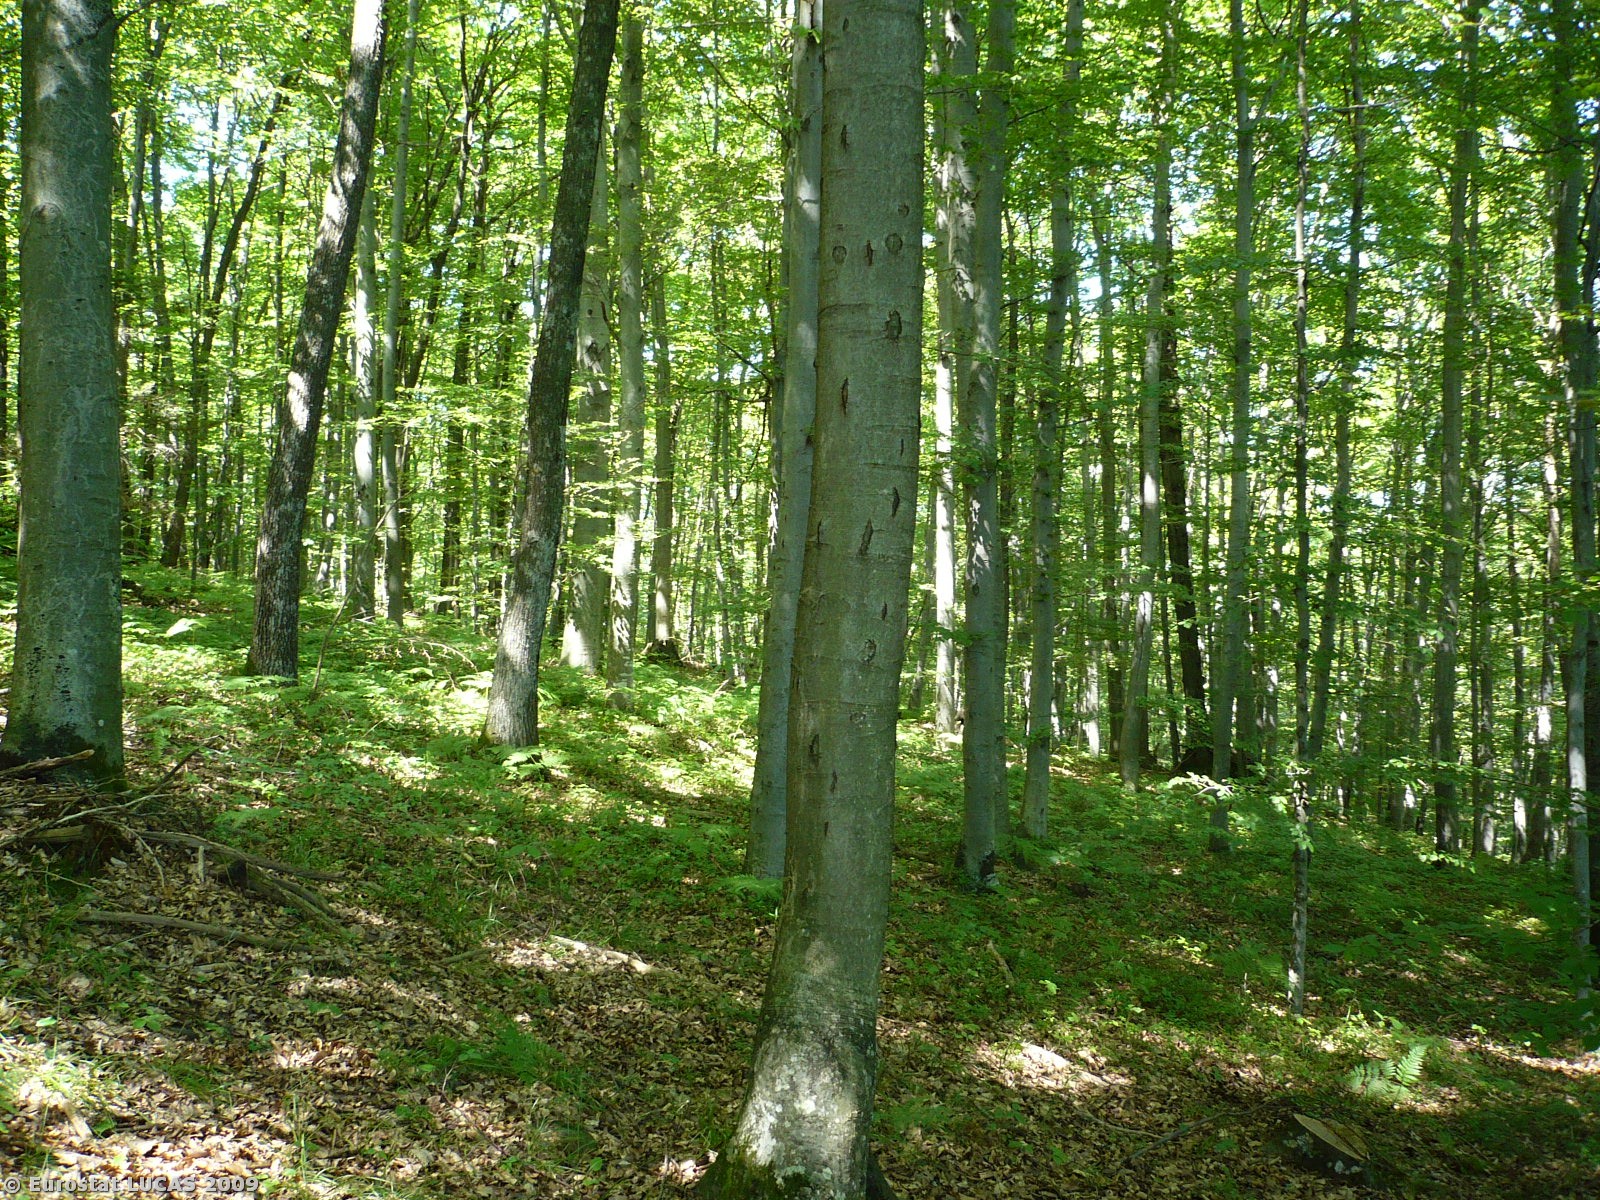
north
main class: Woodland
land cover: Broadleaved woodland
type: beech forest
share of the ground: > 75 %
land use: Forestry
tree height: > 5 m
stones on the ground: < 10 %
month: July
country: SI
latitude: 45.9684
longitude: 15.2752
